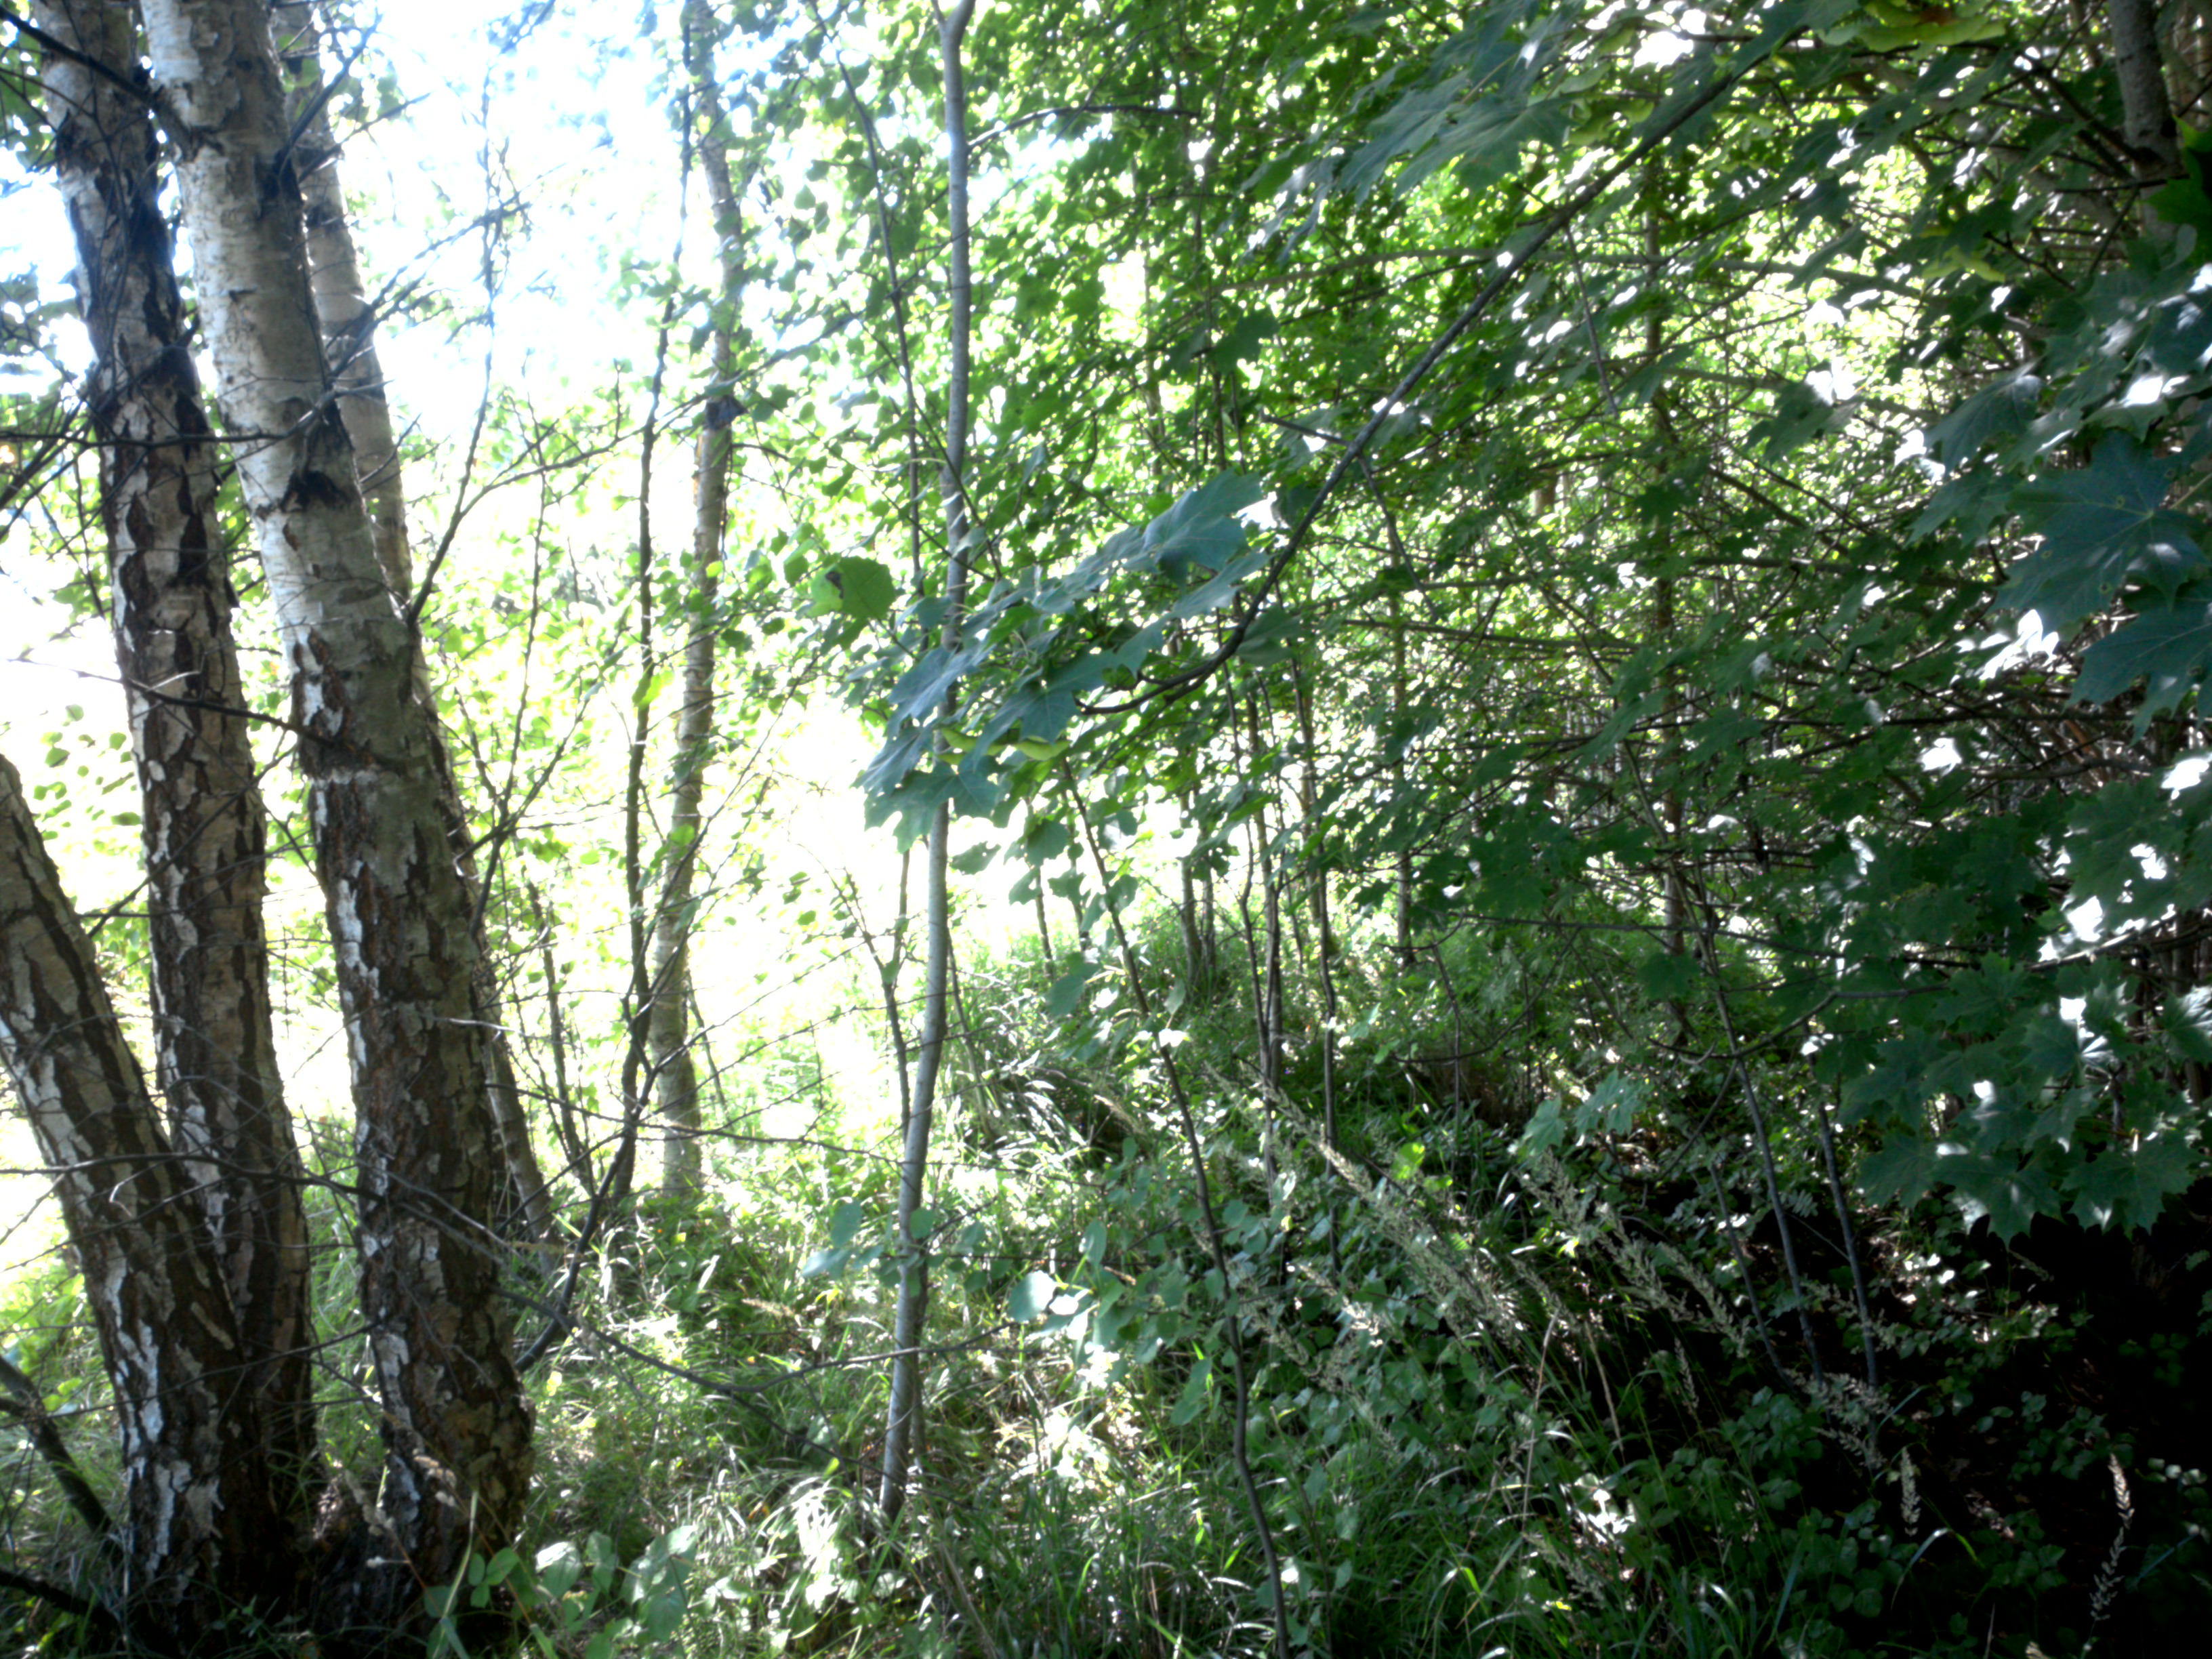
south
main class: Woodland
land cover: Broadleaved woodland
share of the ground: 50 - 75 %
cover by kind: broadleaved forest trees 50 %, herbaceous plants 50 %
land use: Forestry
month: August
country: SE
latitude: 59.1593
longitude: 17.6399
